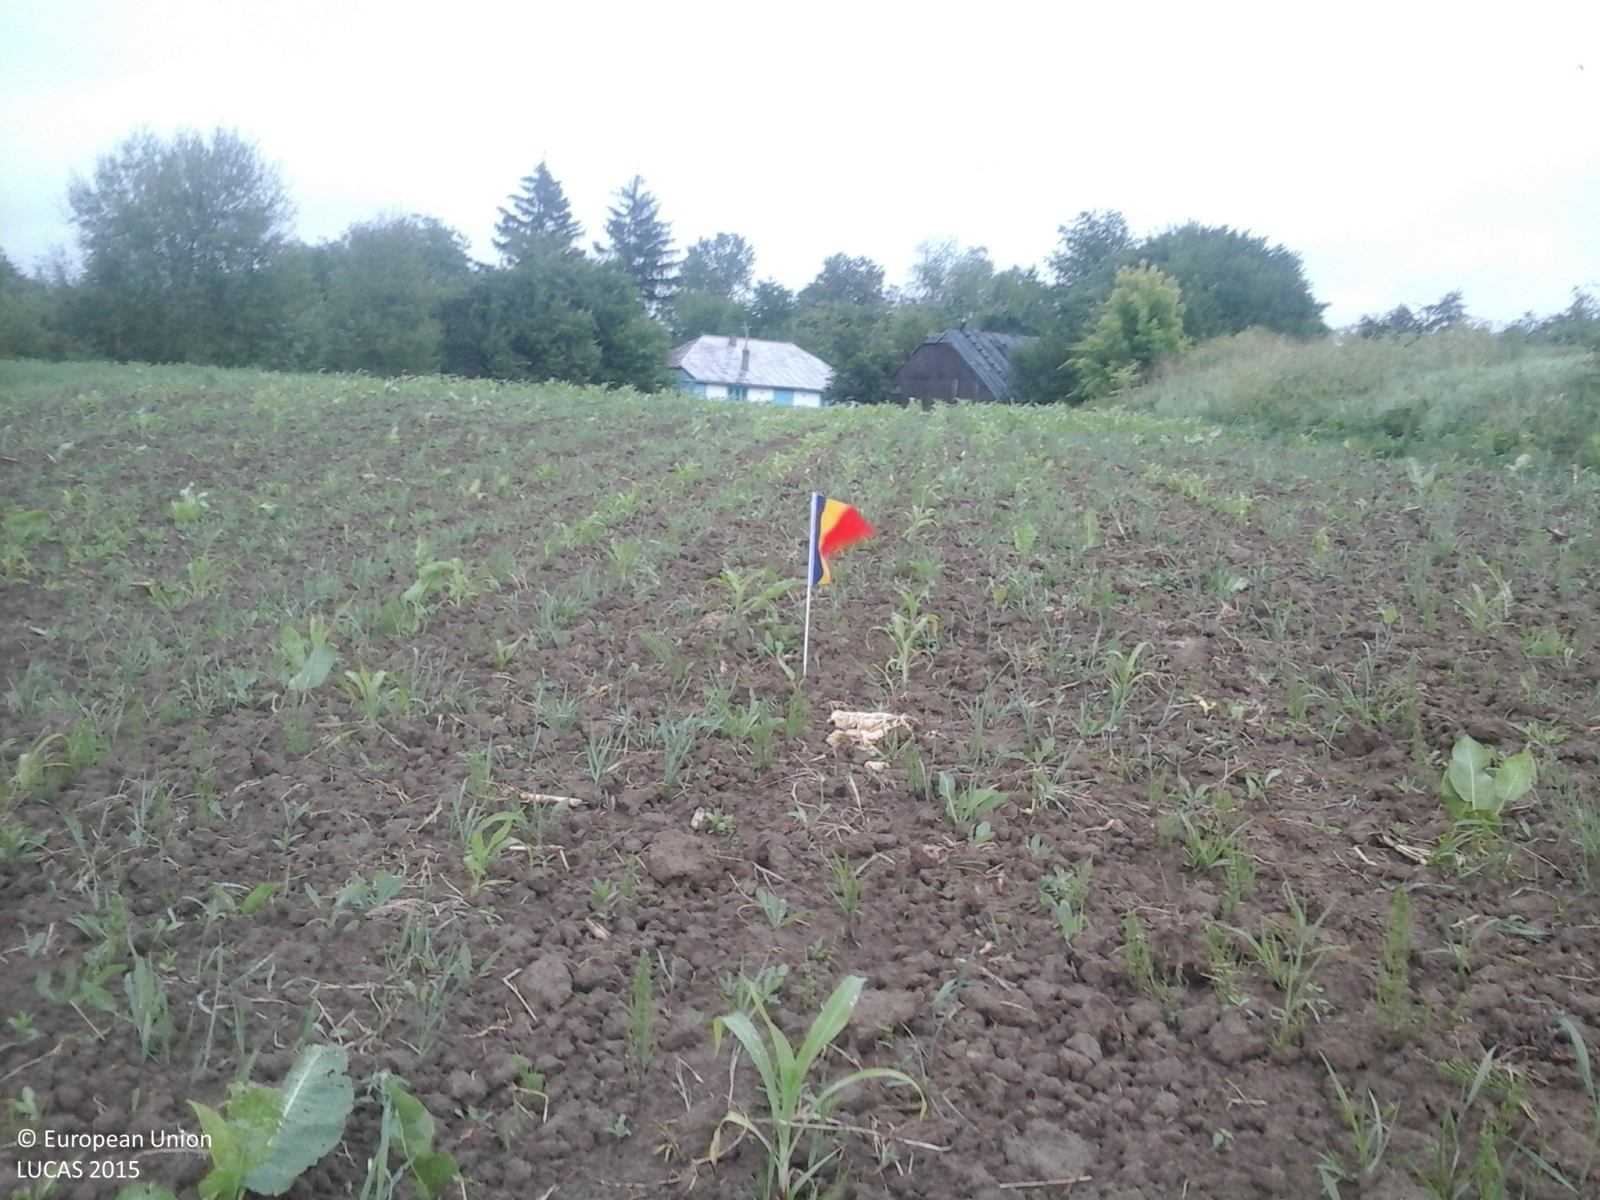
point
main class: Cropland
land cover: Maize
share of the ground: 25 - 50 %
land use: Agriculture (excluding fallow land and kitchen gardens)
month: June
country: RO
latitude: 47.8622
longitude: 26.3001
